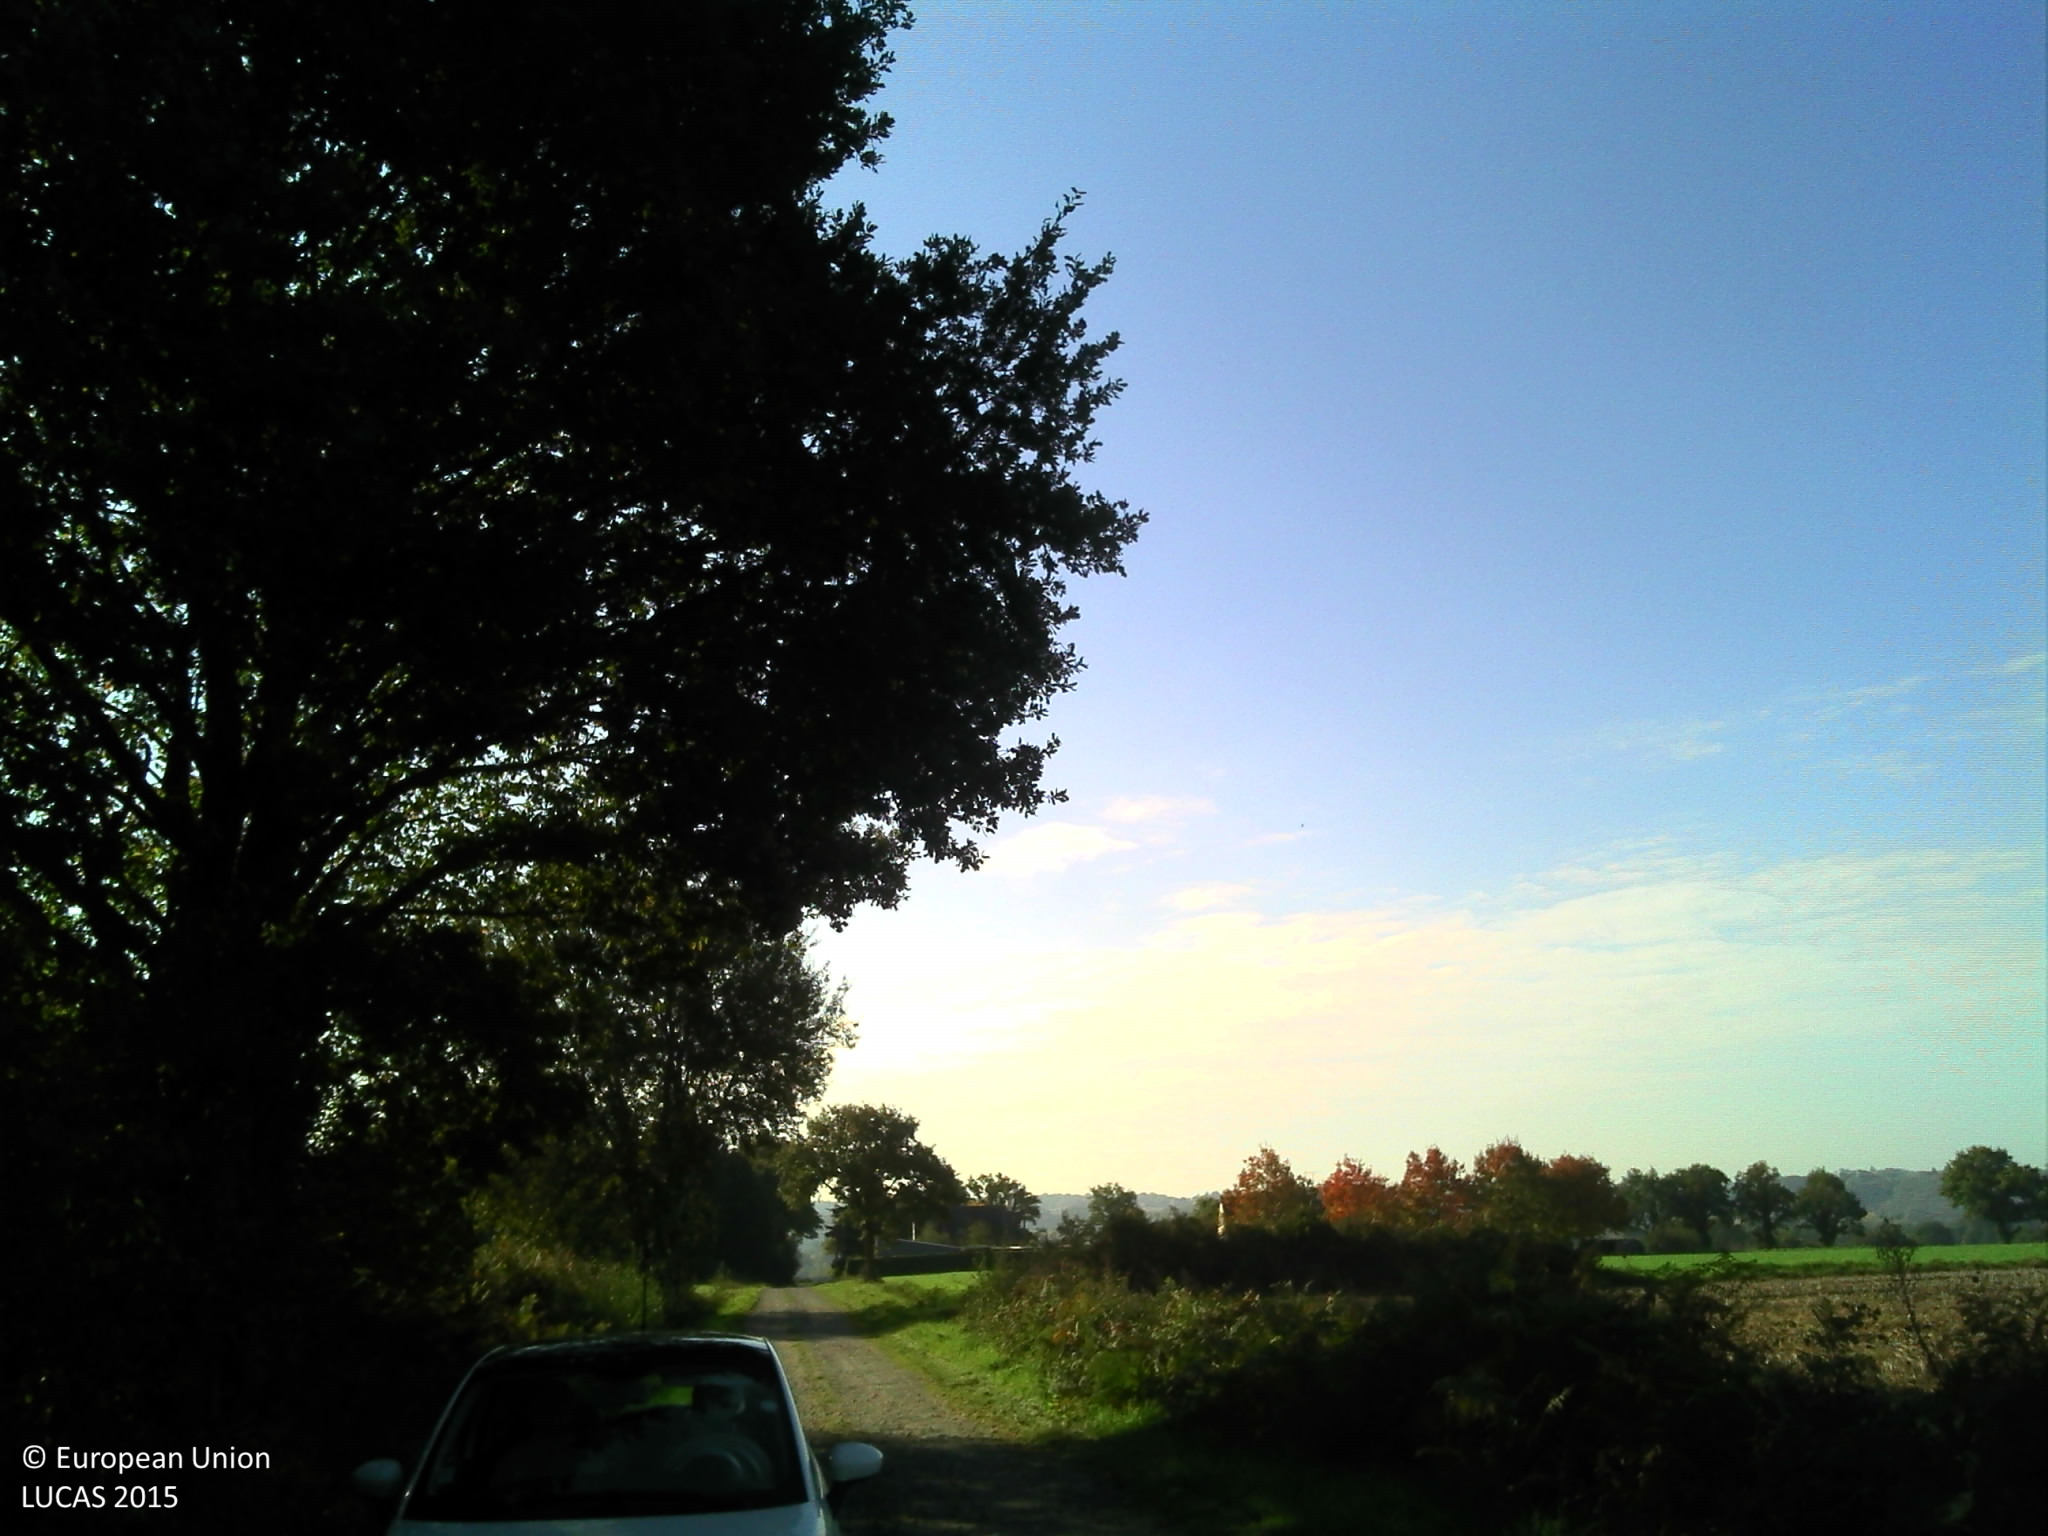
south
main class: Woodland
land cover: Broadleaved woodland
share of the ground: > 75 %
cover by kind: broadleaved forest trees 100 %
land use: Semi-natural and natural areas not in use
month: October
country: FR
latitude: 47.7428
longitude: -2.2034
